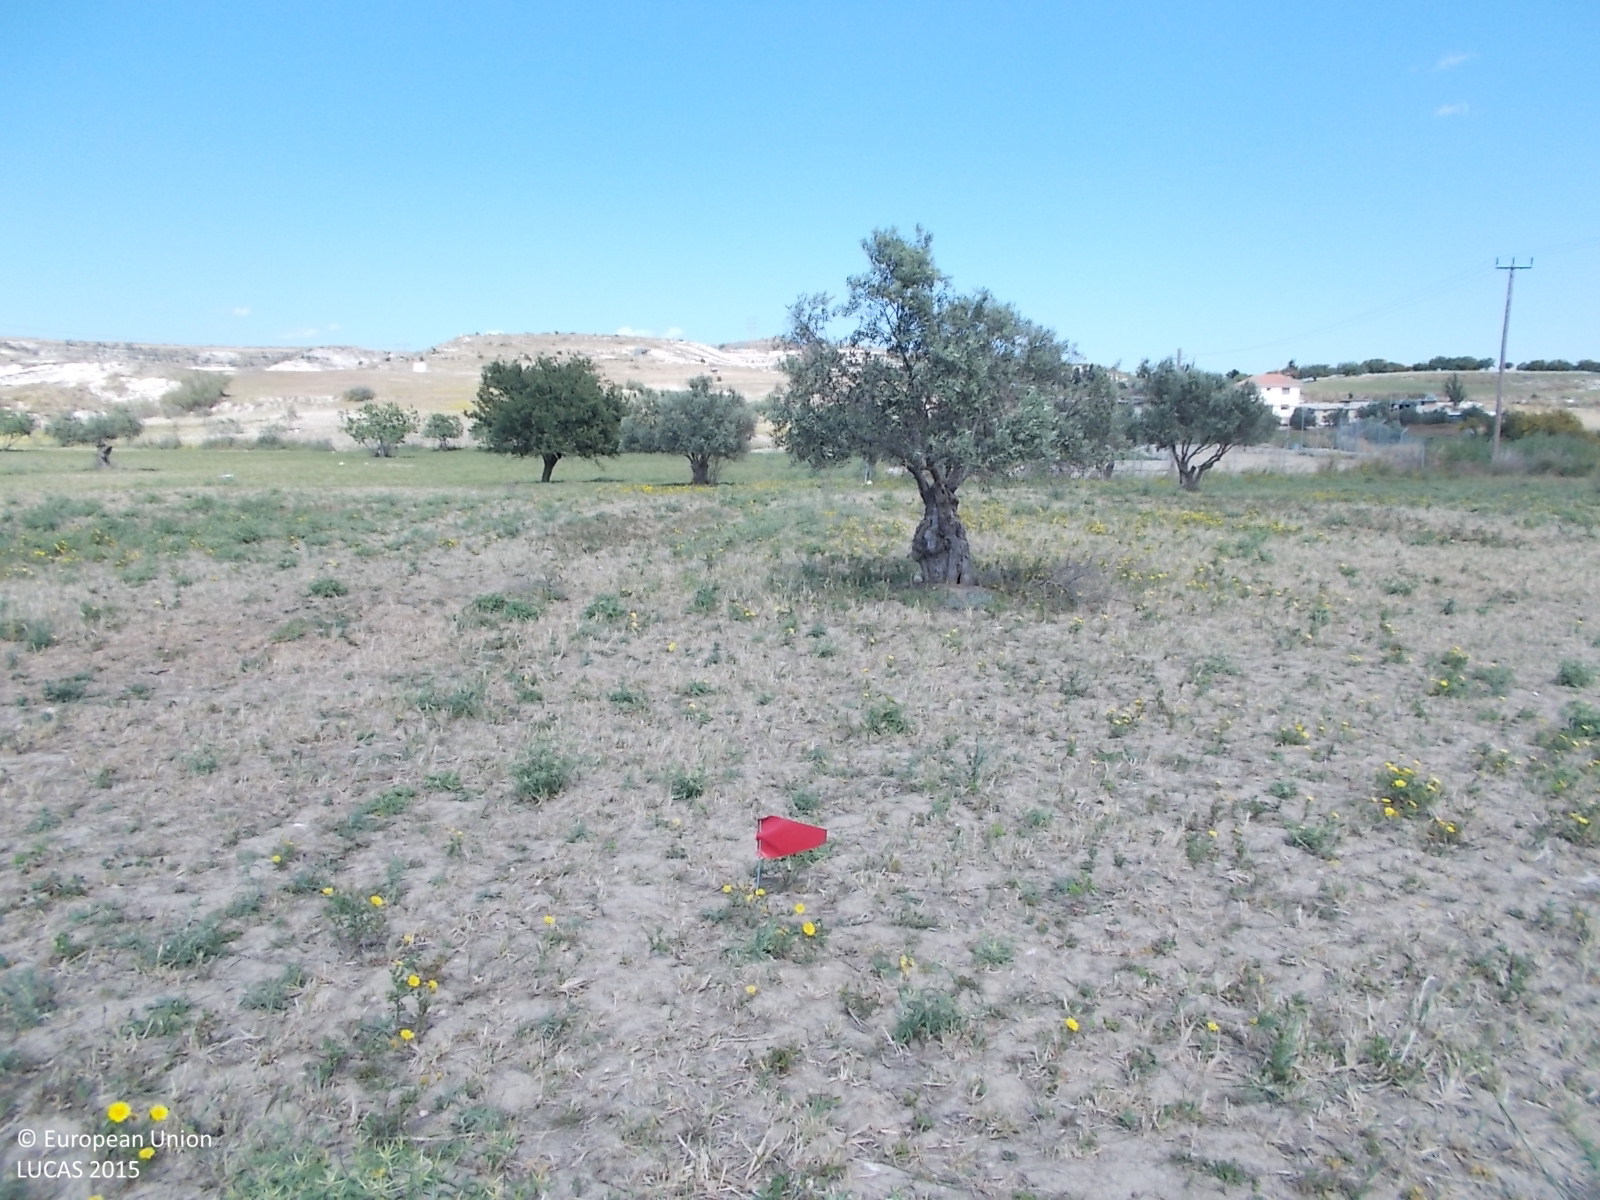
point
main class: Grassland
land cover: Grassland with sparse tree/shrub cover
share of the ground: 10 - 25 %
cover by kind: unconsolidated bare surface 80 %, herbaceous plants 15 %, broadleaved forest trees 5 %
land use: Agriculture (excluding fallow land and kitchen gardens)
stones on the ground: < 10 %
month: April
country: CY
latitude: 34.9986
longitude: 33.6585
